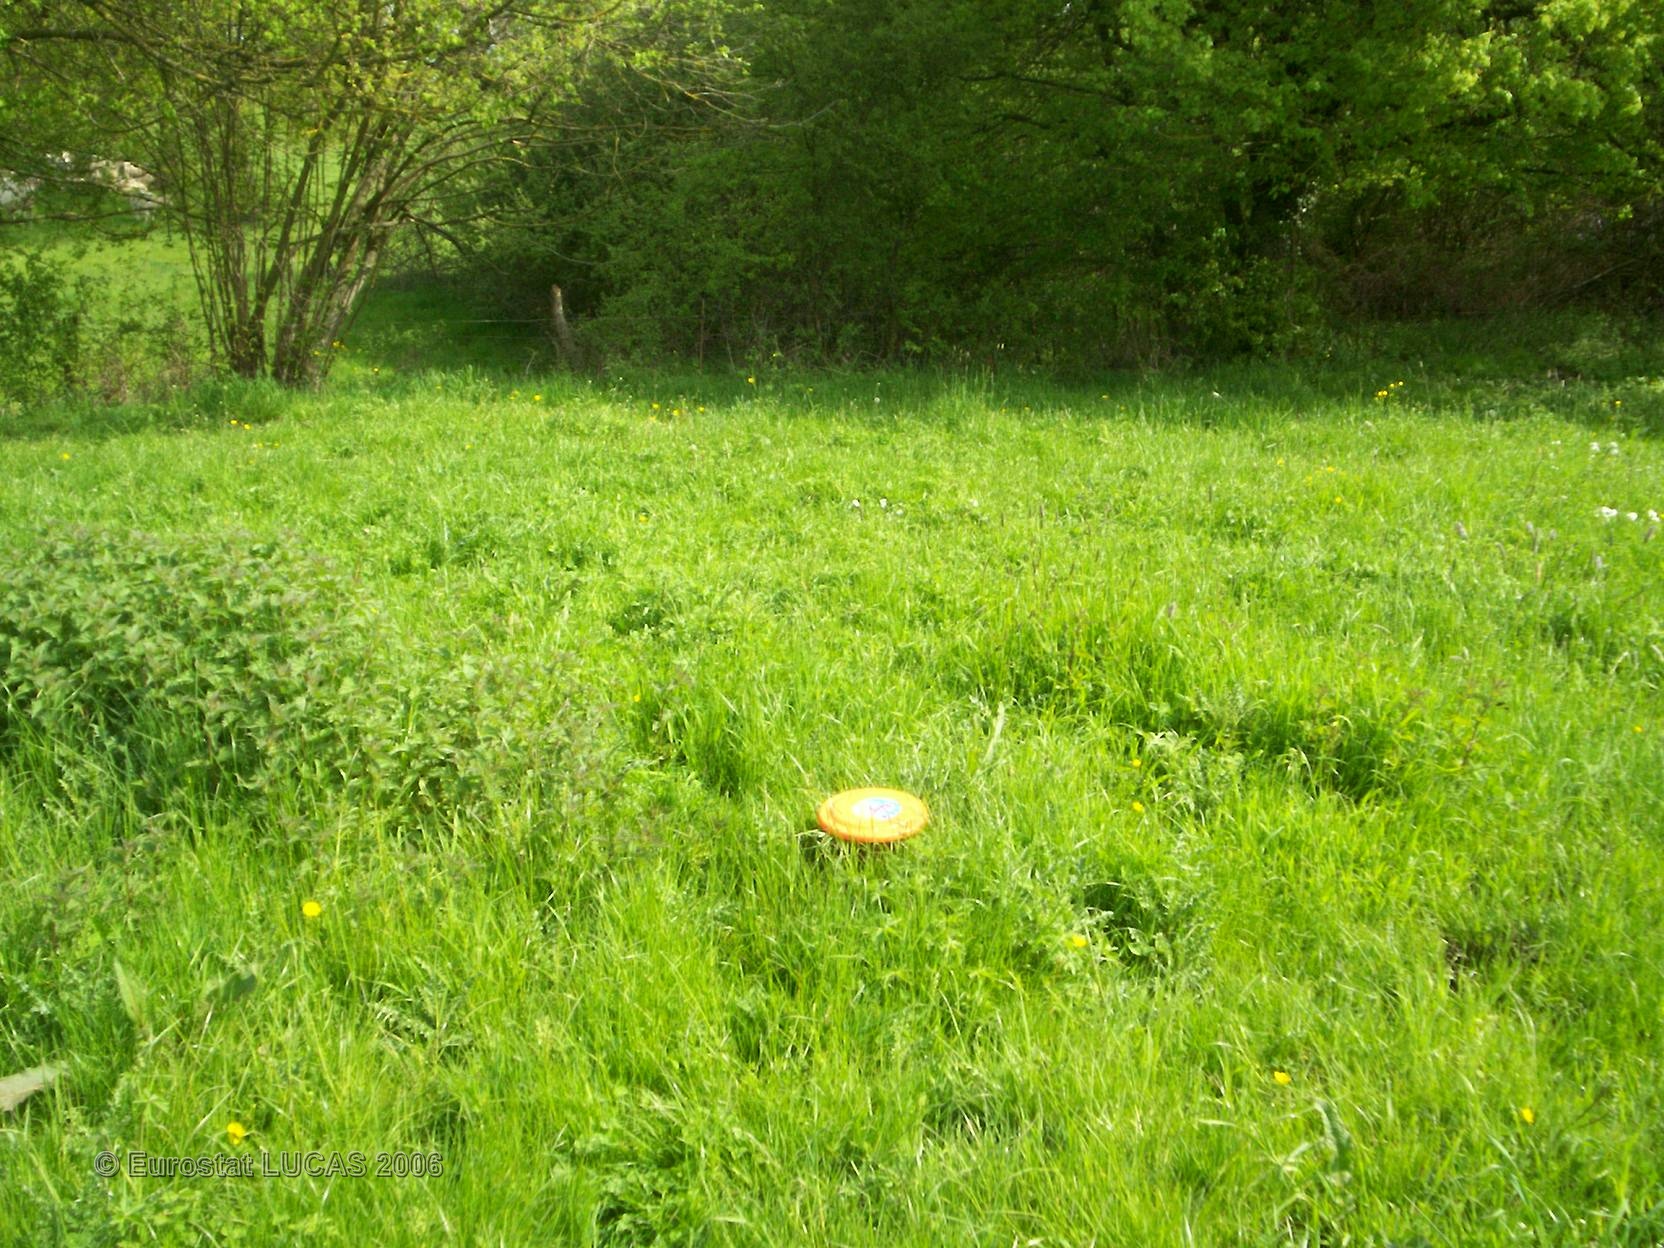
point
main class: Grassland
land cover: Grassland with sparse tree/shrub cover
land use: Agriculture (excluding fallow land and kitchen gardens)
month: May
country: FR
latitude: 46.3663
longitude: 3.1479
